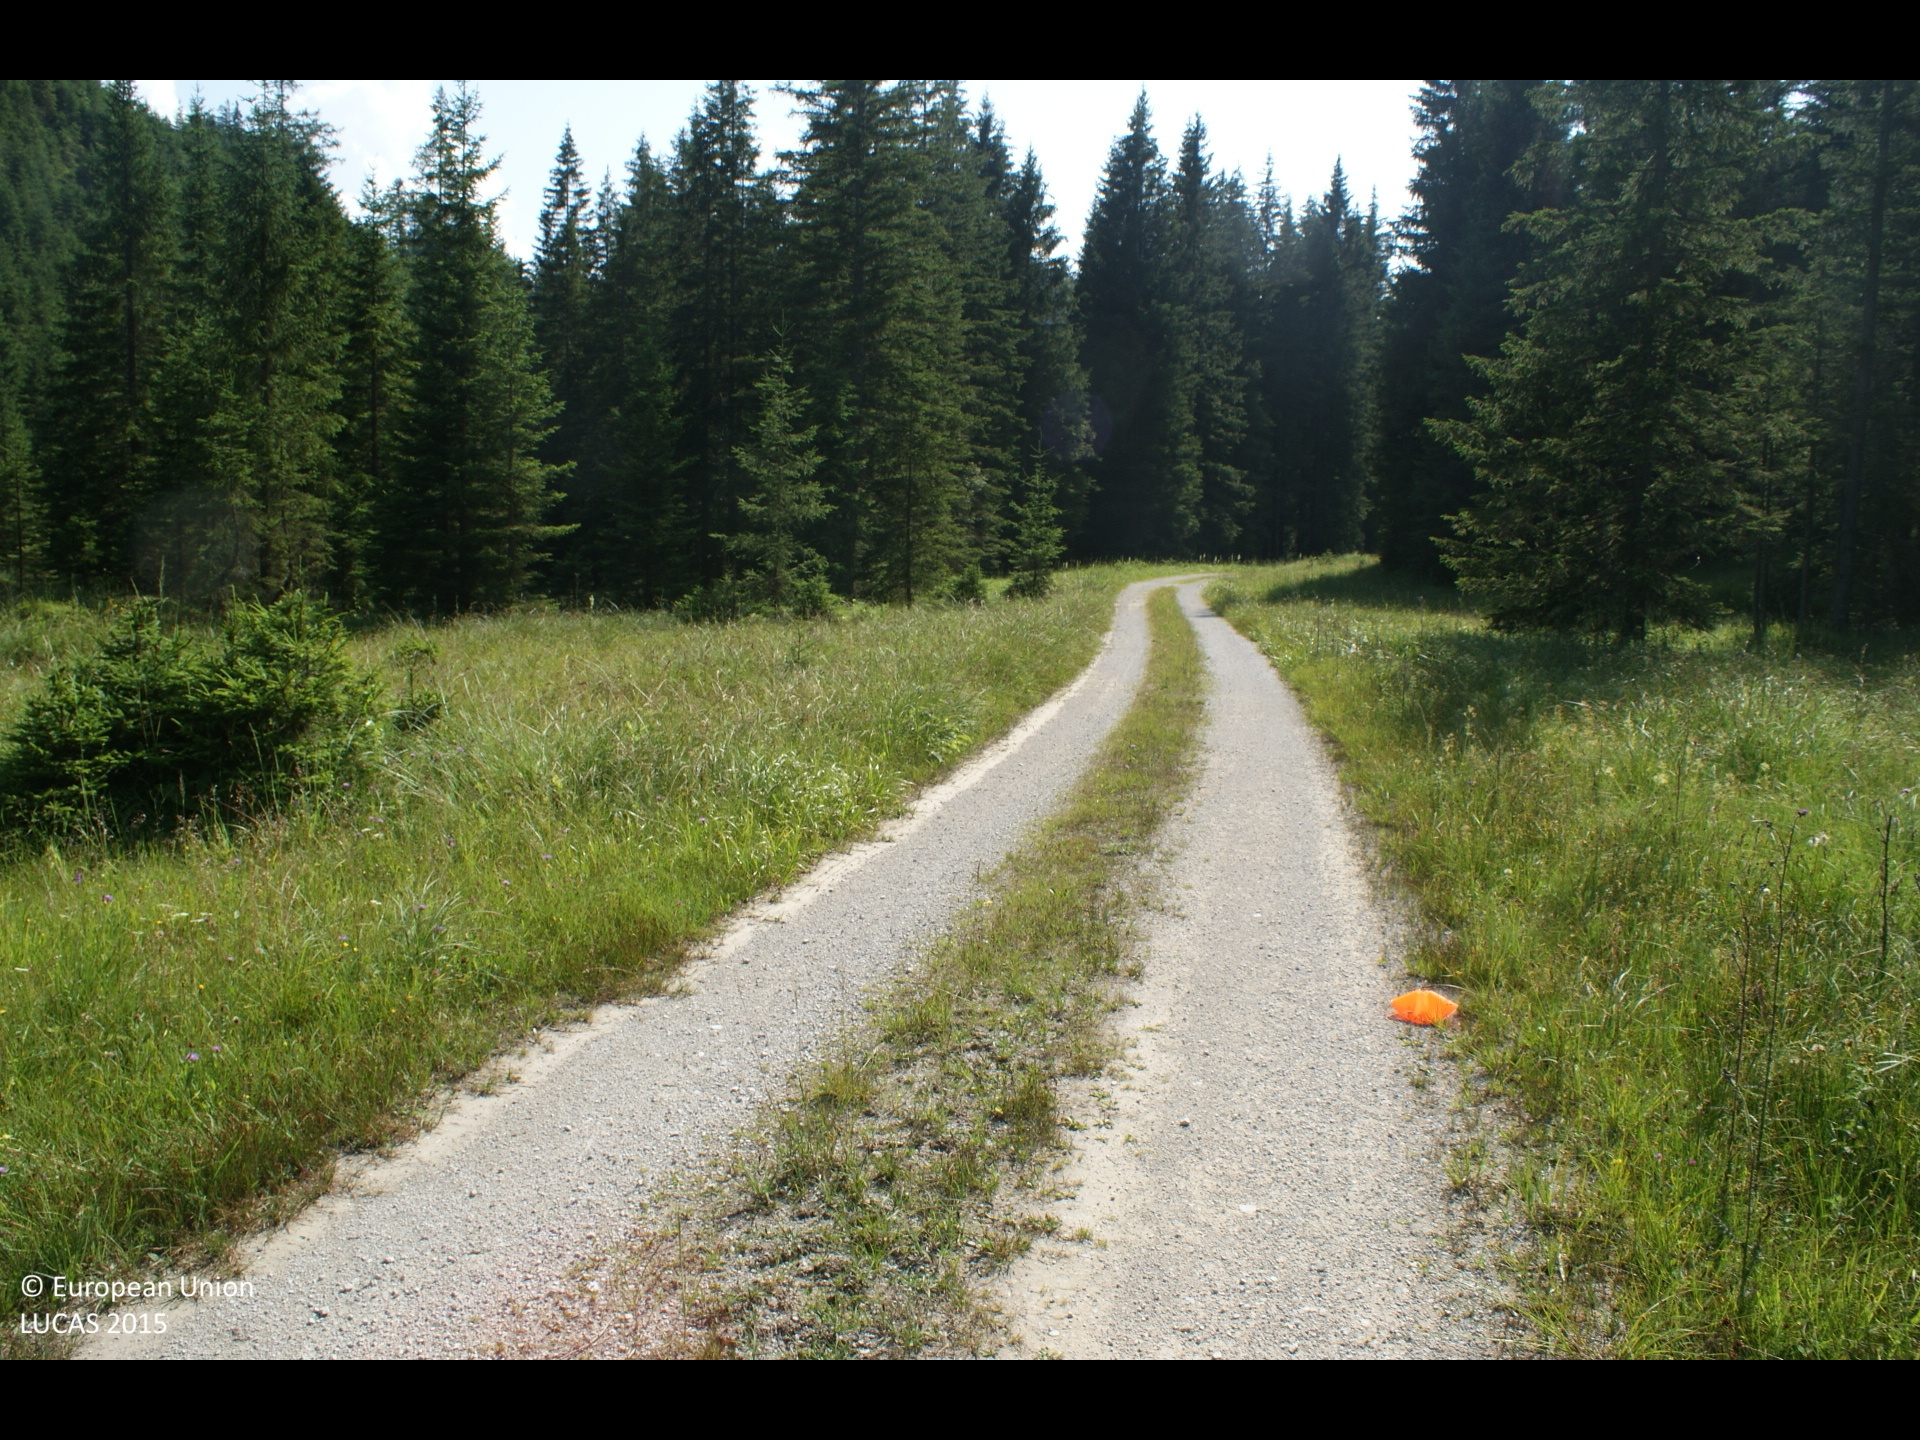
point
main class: Grassland
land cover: Spontaneously vegetated surfaces
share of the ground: > 75 %
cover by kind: herbaceous plants 100 %
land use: Semi-natural and natural areas not in use
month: July
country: AT
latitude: 47.8561
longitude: 15.4145
